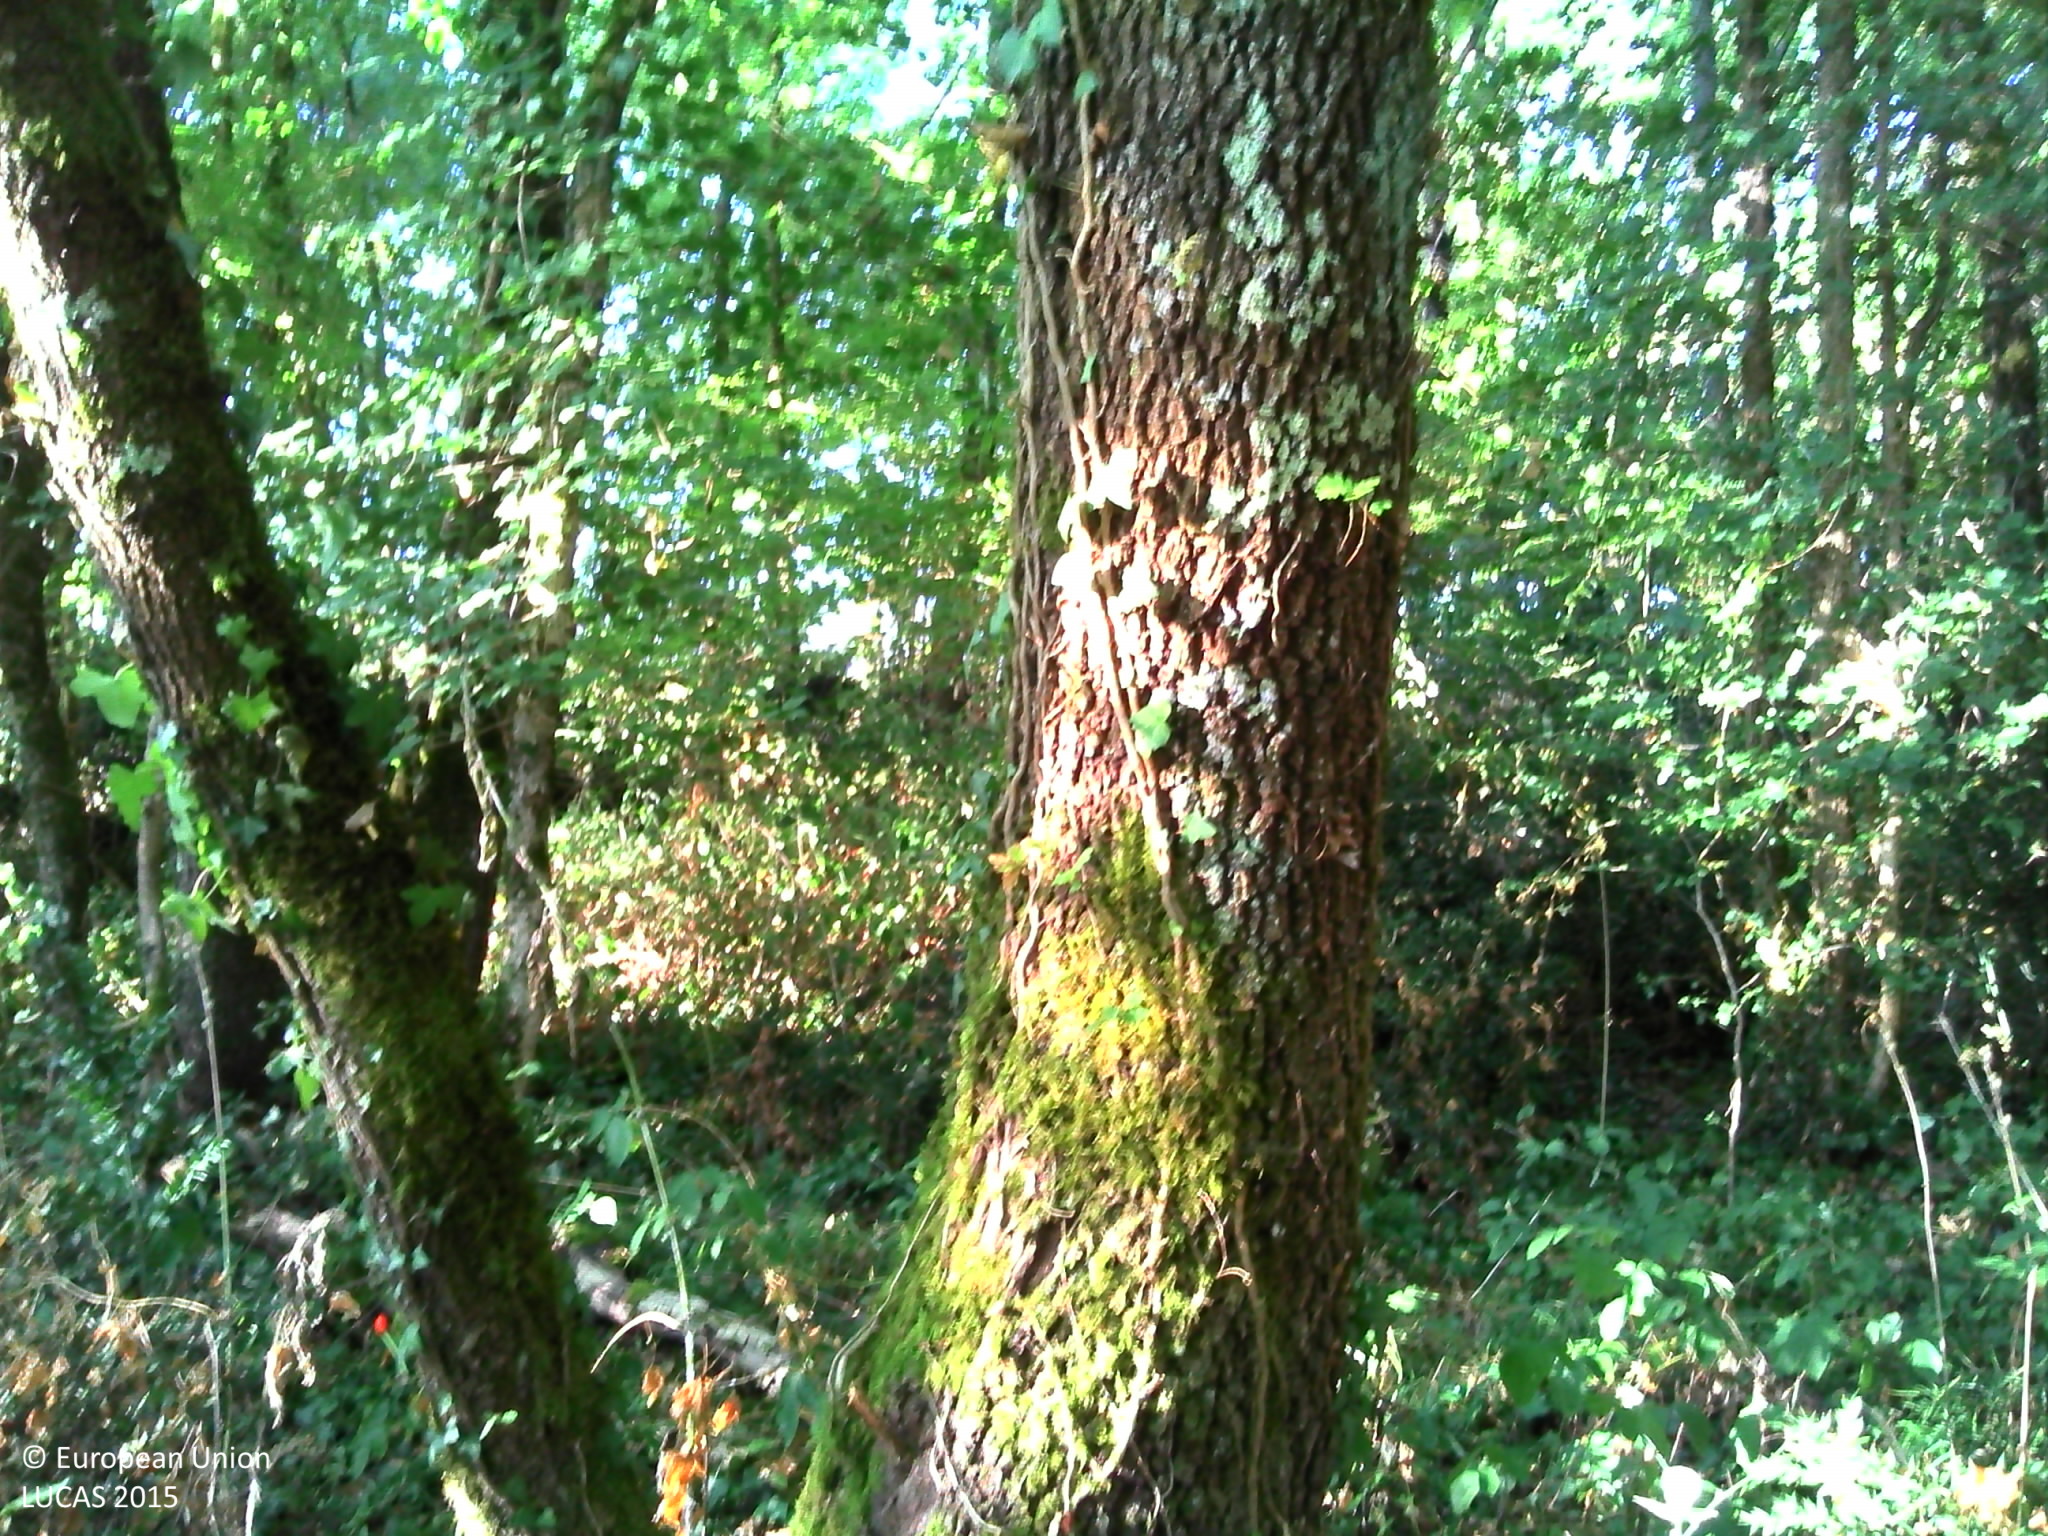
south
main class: Woodland
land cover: Broadleaved woodland
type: acidophilous oak and oak-birch forest
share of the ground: > 75 %
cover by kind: broadleaved forest trees 80 %, herbaceous plants 10 %, shrubs 5 %, lichens and mosses 5 %
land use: Forestry
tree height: > 5 m
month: July
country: FR
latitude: 44.7202
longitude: 0.5863
